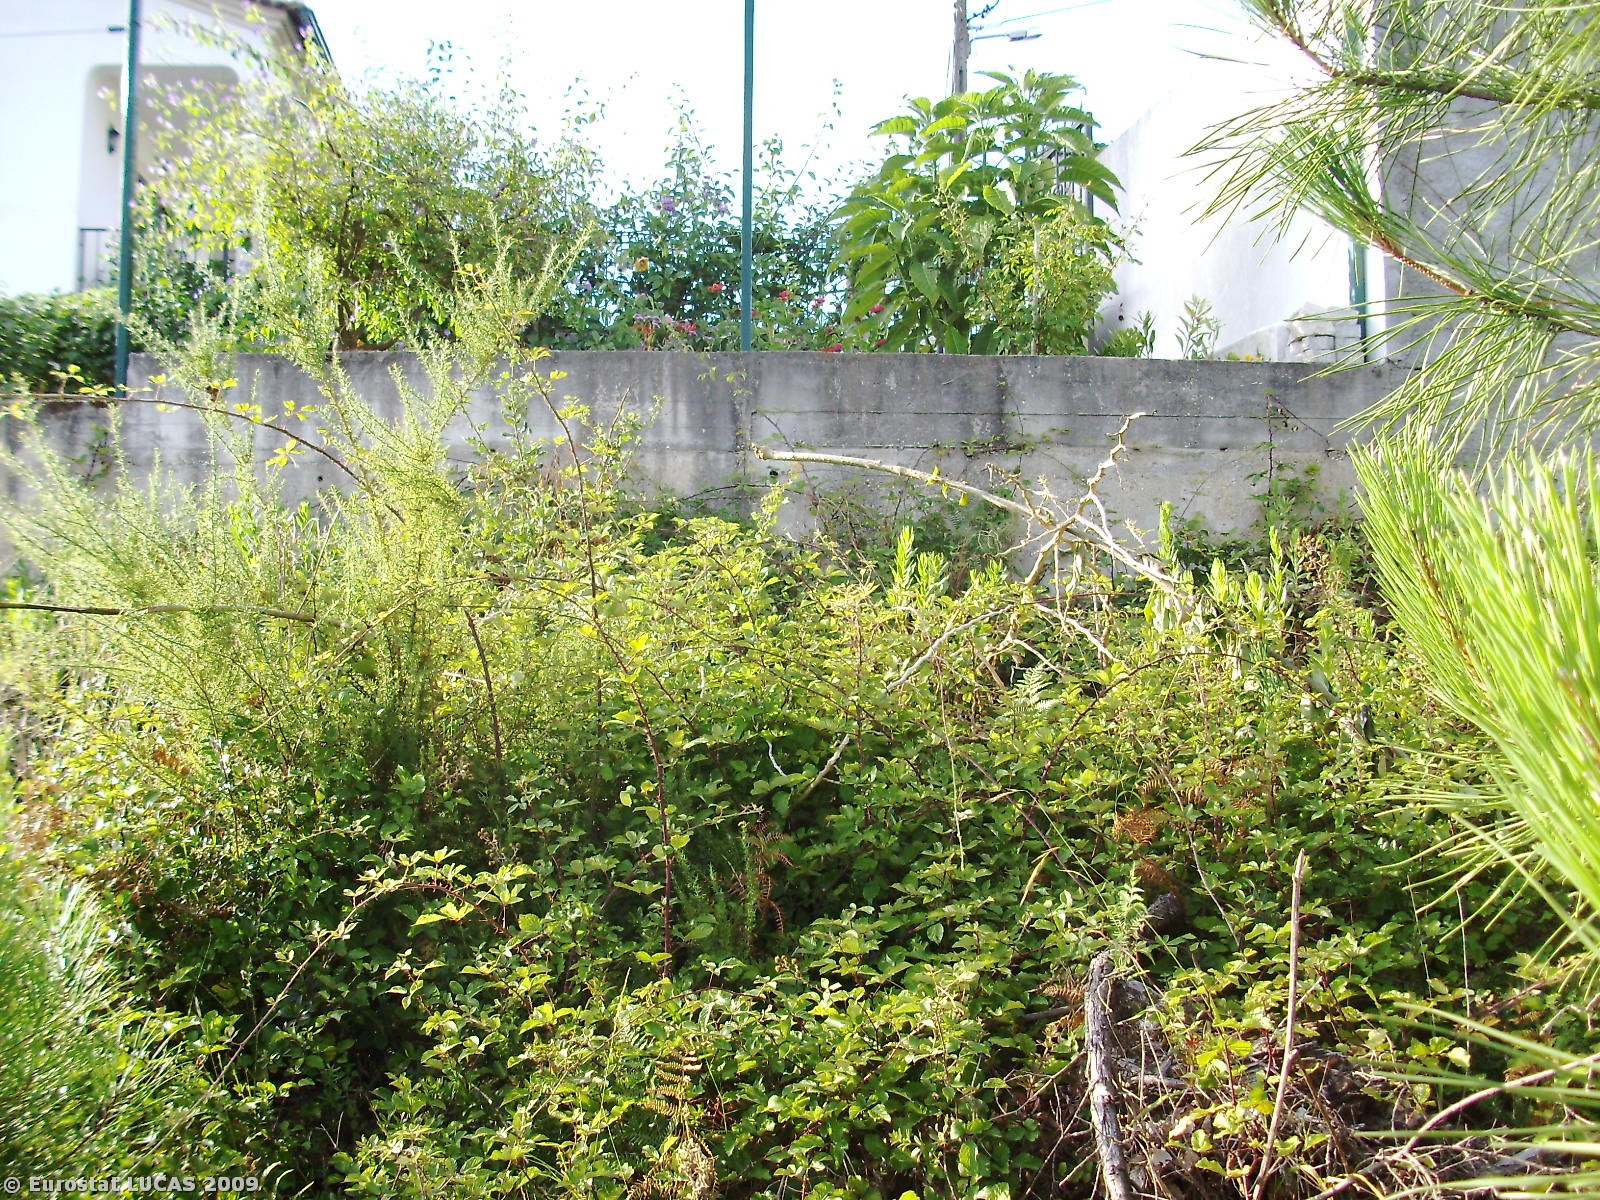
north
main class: Woodland
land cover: Coniferous woodland
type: coniferous forest of the mediterranean region
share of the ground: 10 - 25 %
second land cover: Shrubland with sparse tree cover
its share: 50 - 75 %
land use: Forestry
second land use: Fallow land
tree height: > 5 m
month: July
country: PT
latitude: 39.6720
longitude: -8.9869
